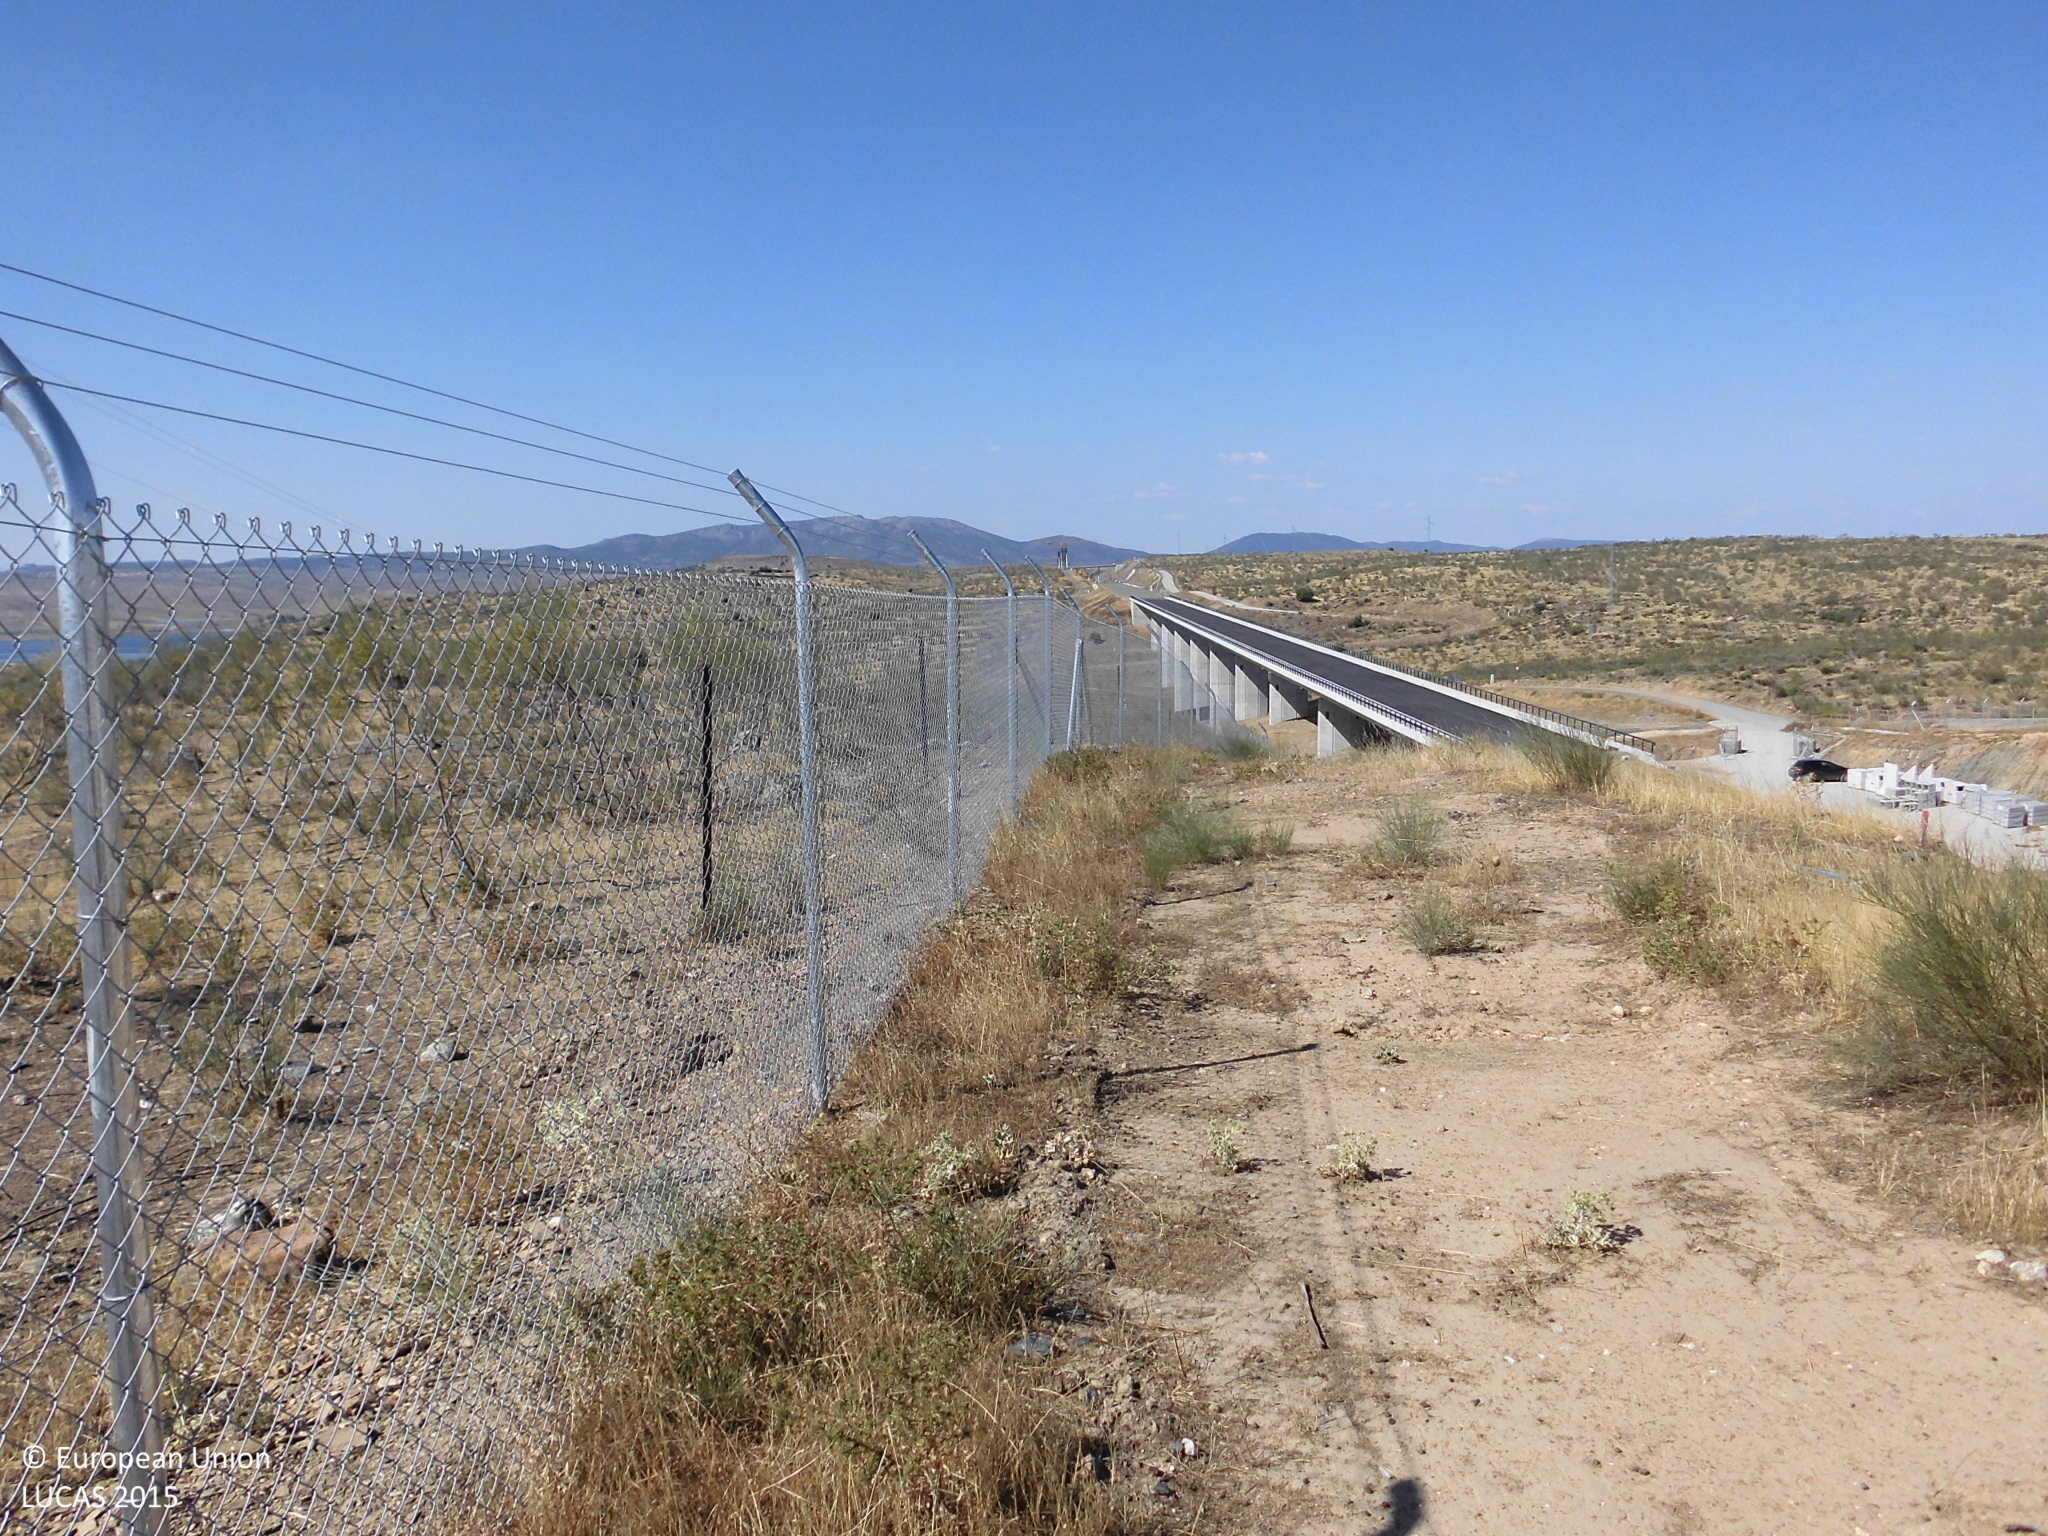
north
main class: Shrubland
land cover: Shrubland with sparse tree cover
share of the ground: 10 - 25 %
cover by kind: herbaceous plants 80 %, shrubs 15 %, broadleaved forest trees 5 %
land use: Forestry
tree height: > 5 m
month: June
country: ES
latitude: 39.6955
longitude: -6.4581
